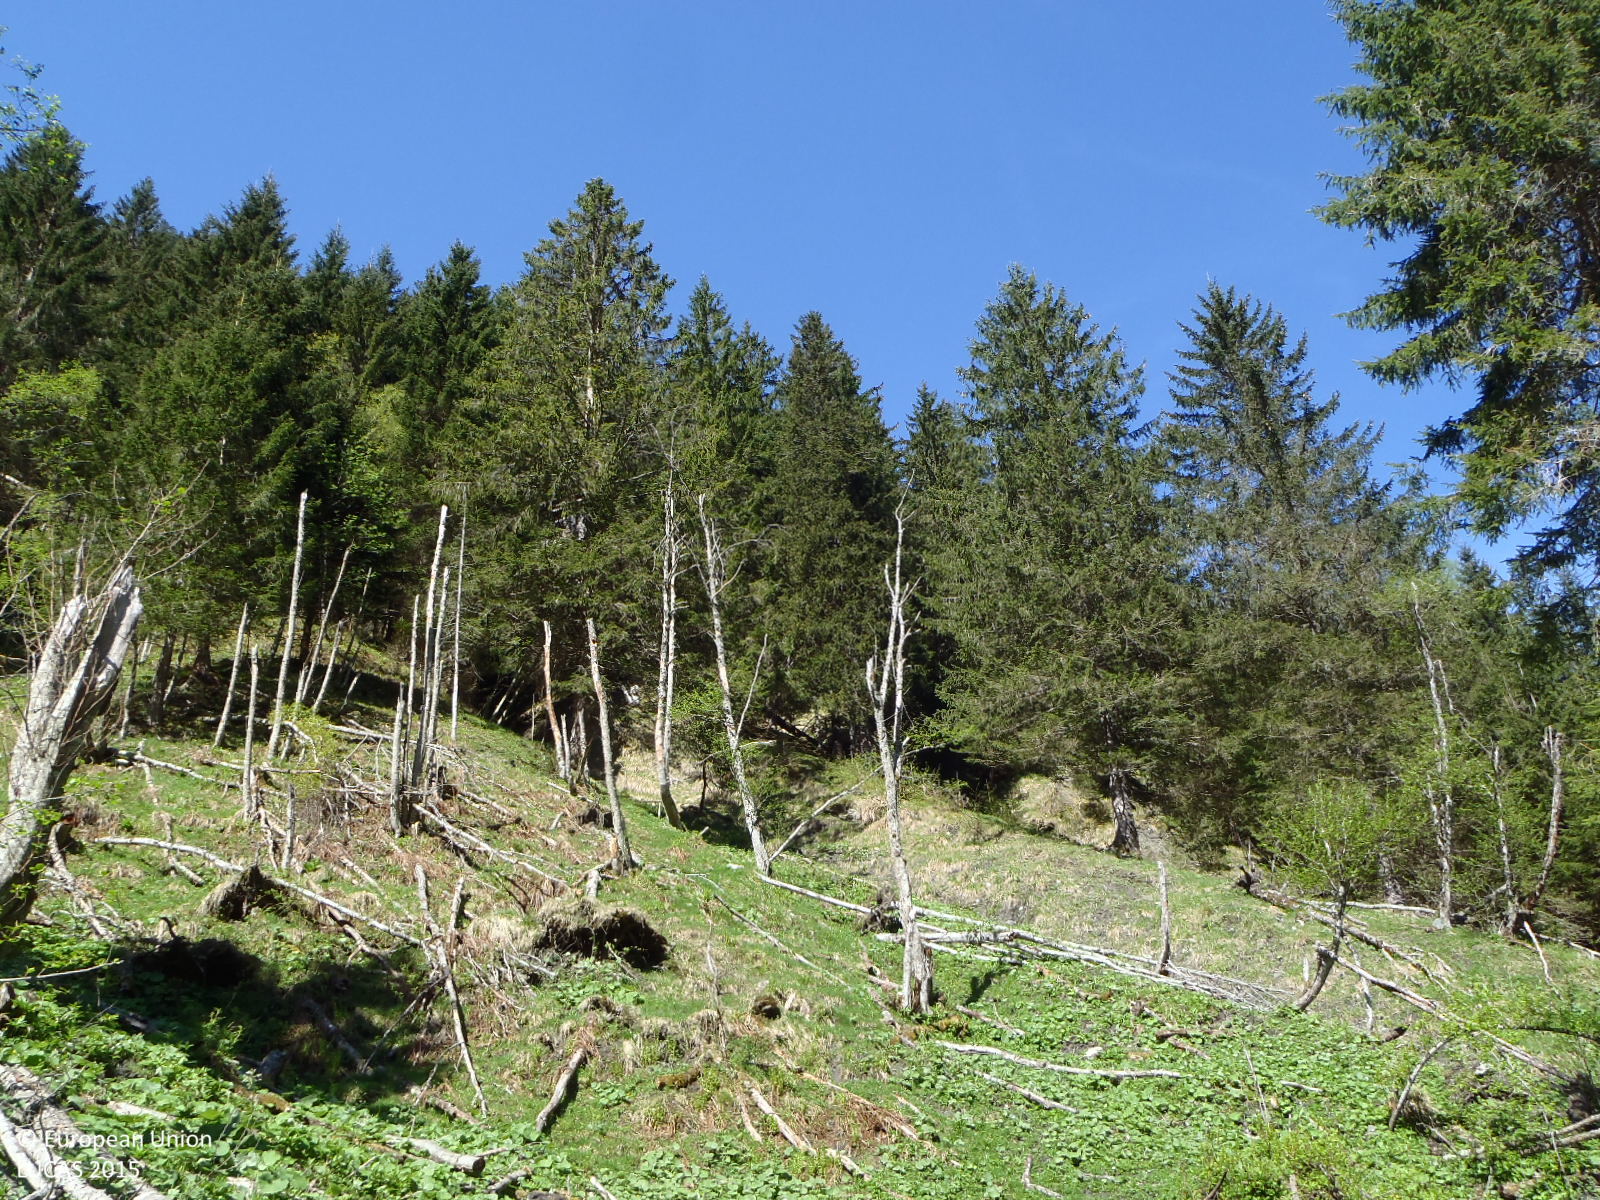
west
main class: Woodland
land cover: Broadleaved woodland
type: mountainous beech forest
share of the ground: 10 - 25 %
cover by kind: herbaceous plants 55 %, broadleaved forest trees 25 %, shrubs 10 %, coniferous forest trees 5 %, unconsolidated bare surface 5 %
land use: Forestry
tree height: > 5 m
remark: Clear cut
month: May
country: AT
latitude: 47.1479
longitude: 13.2816
